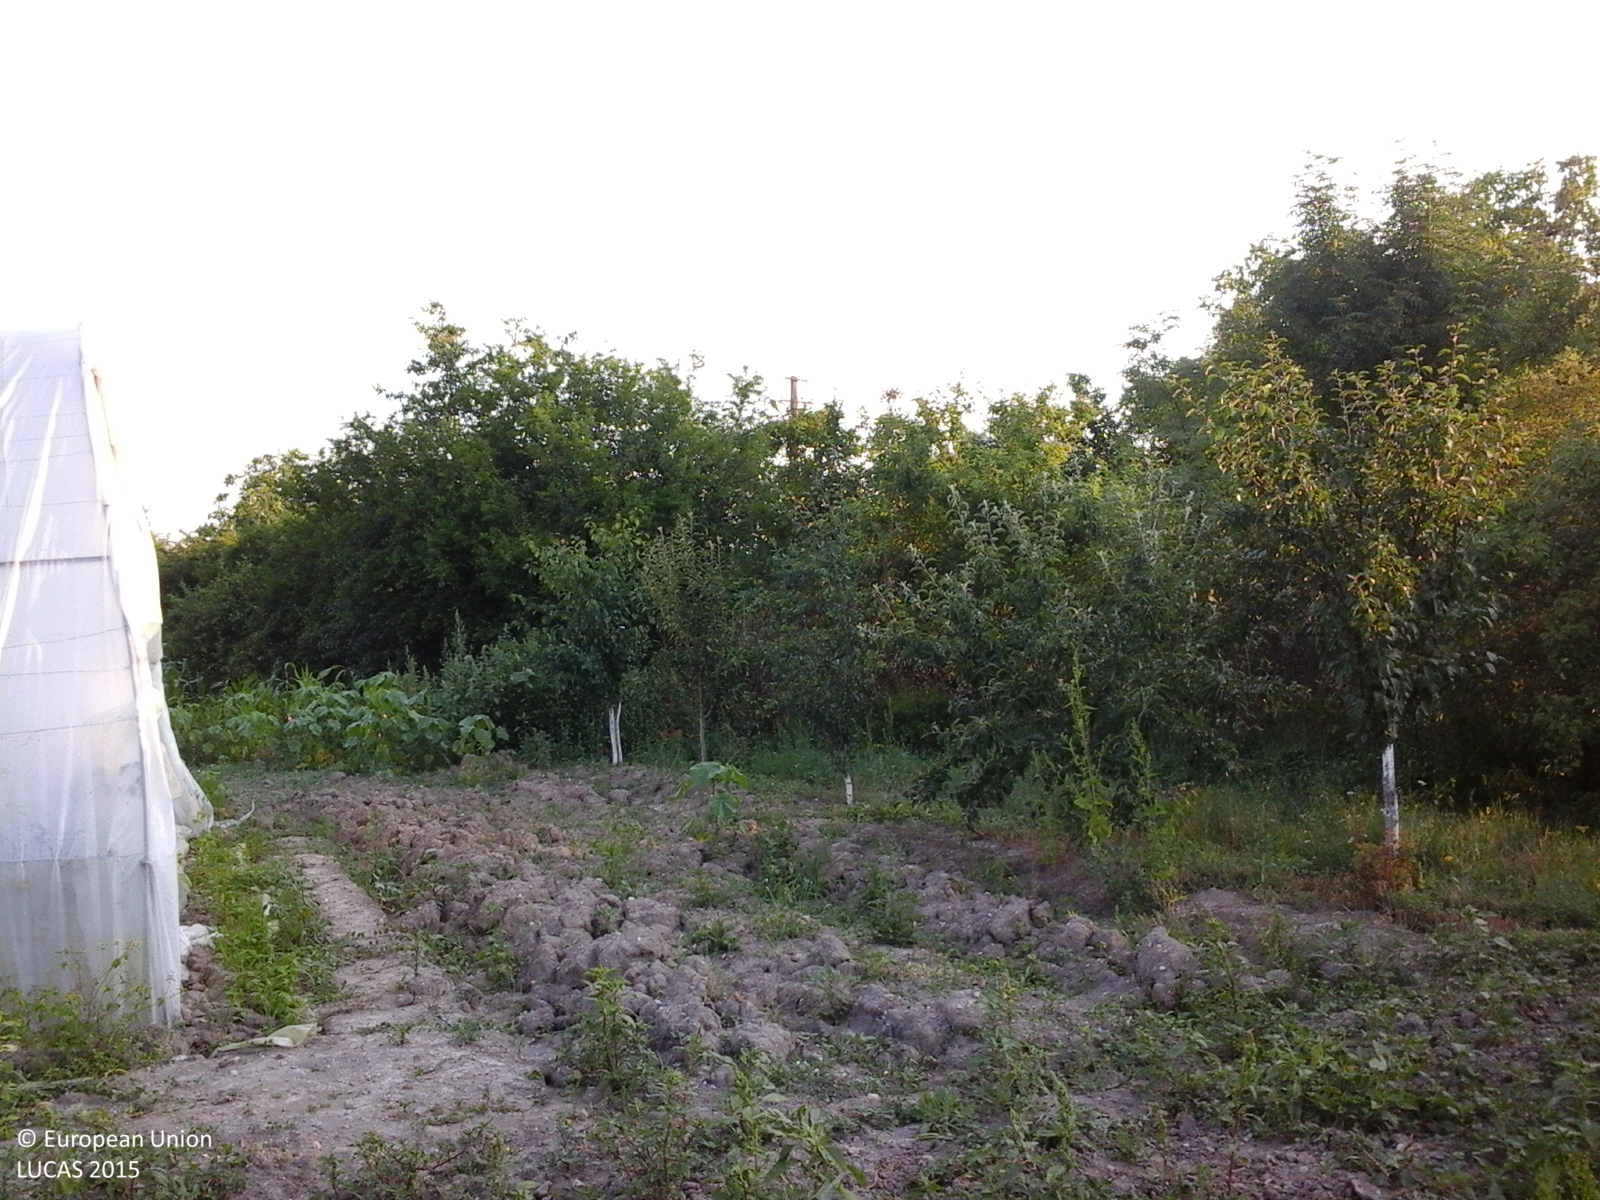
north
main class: Grassland
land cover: Spontaneously vegetated surfaces
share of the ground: 50 - 75 %
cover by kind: herbaceous plants 65 %, unconsolidated bare surface 35 %
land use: Agriculture (excluding fallow land and kitchen gardens)
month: July
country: RO
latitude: 44.5859
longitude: 24.6477
